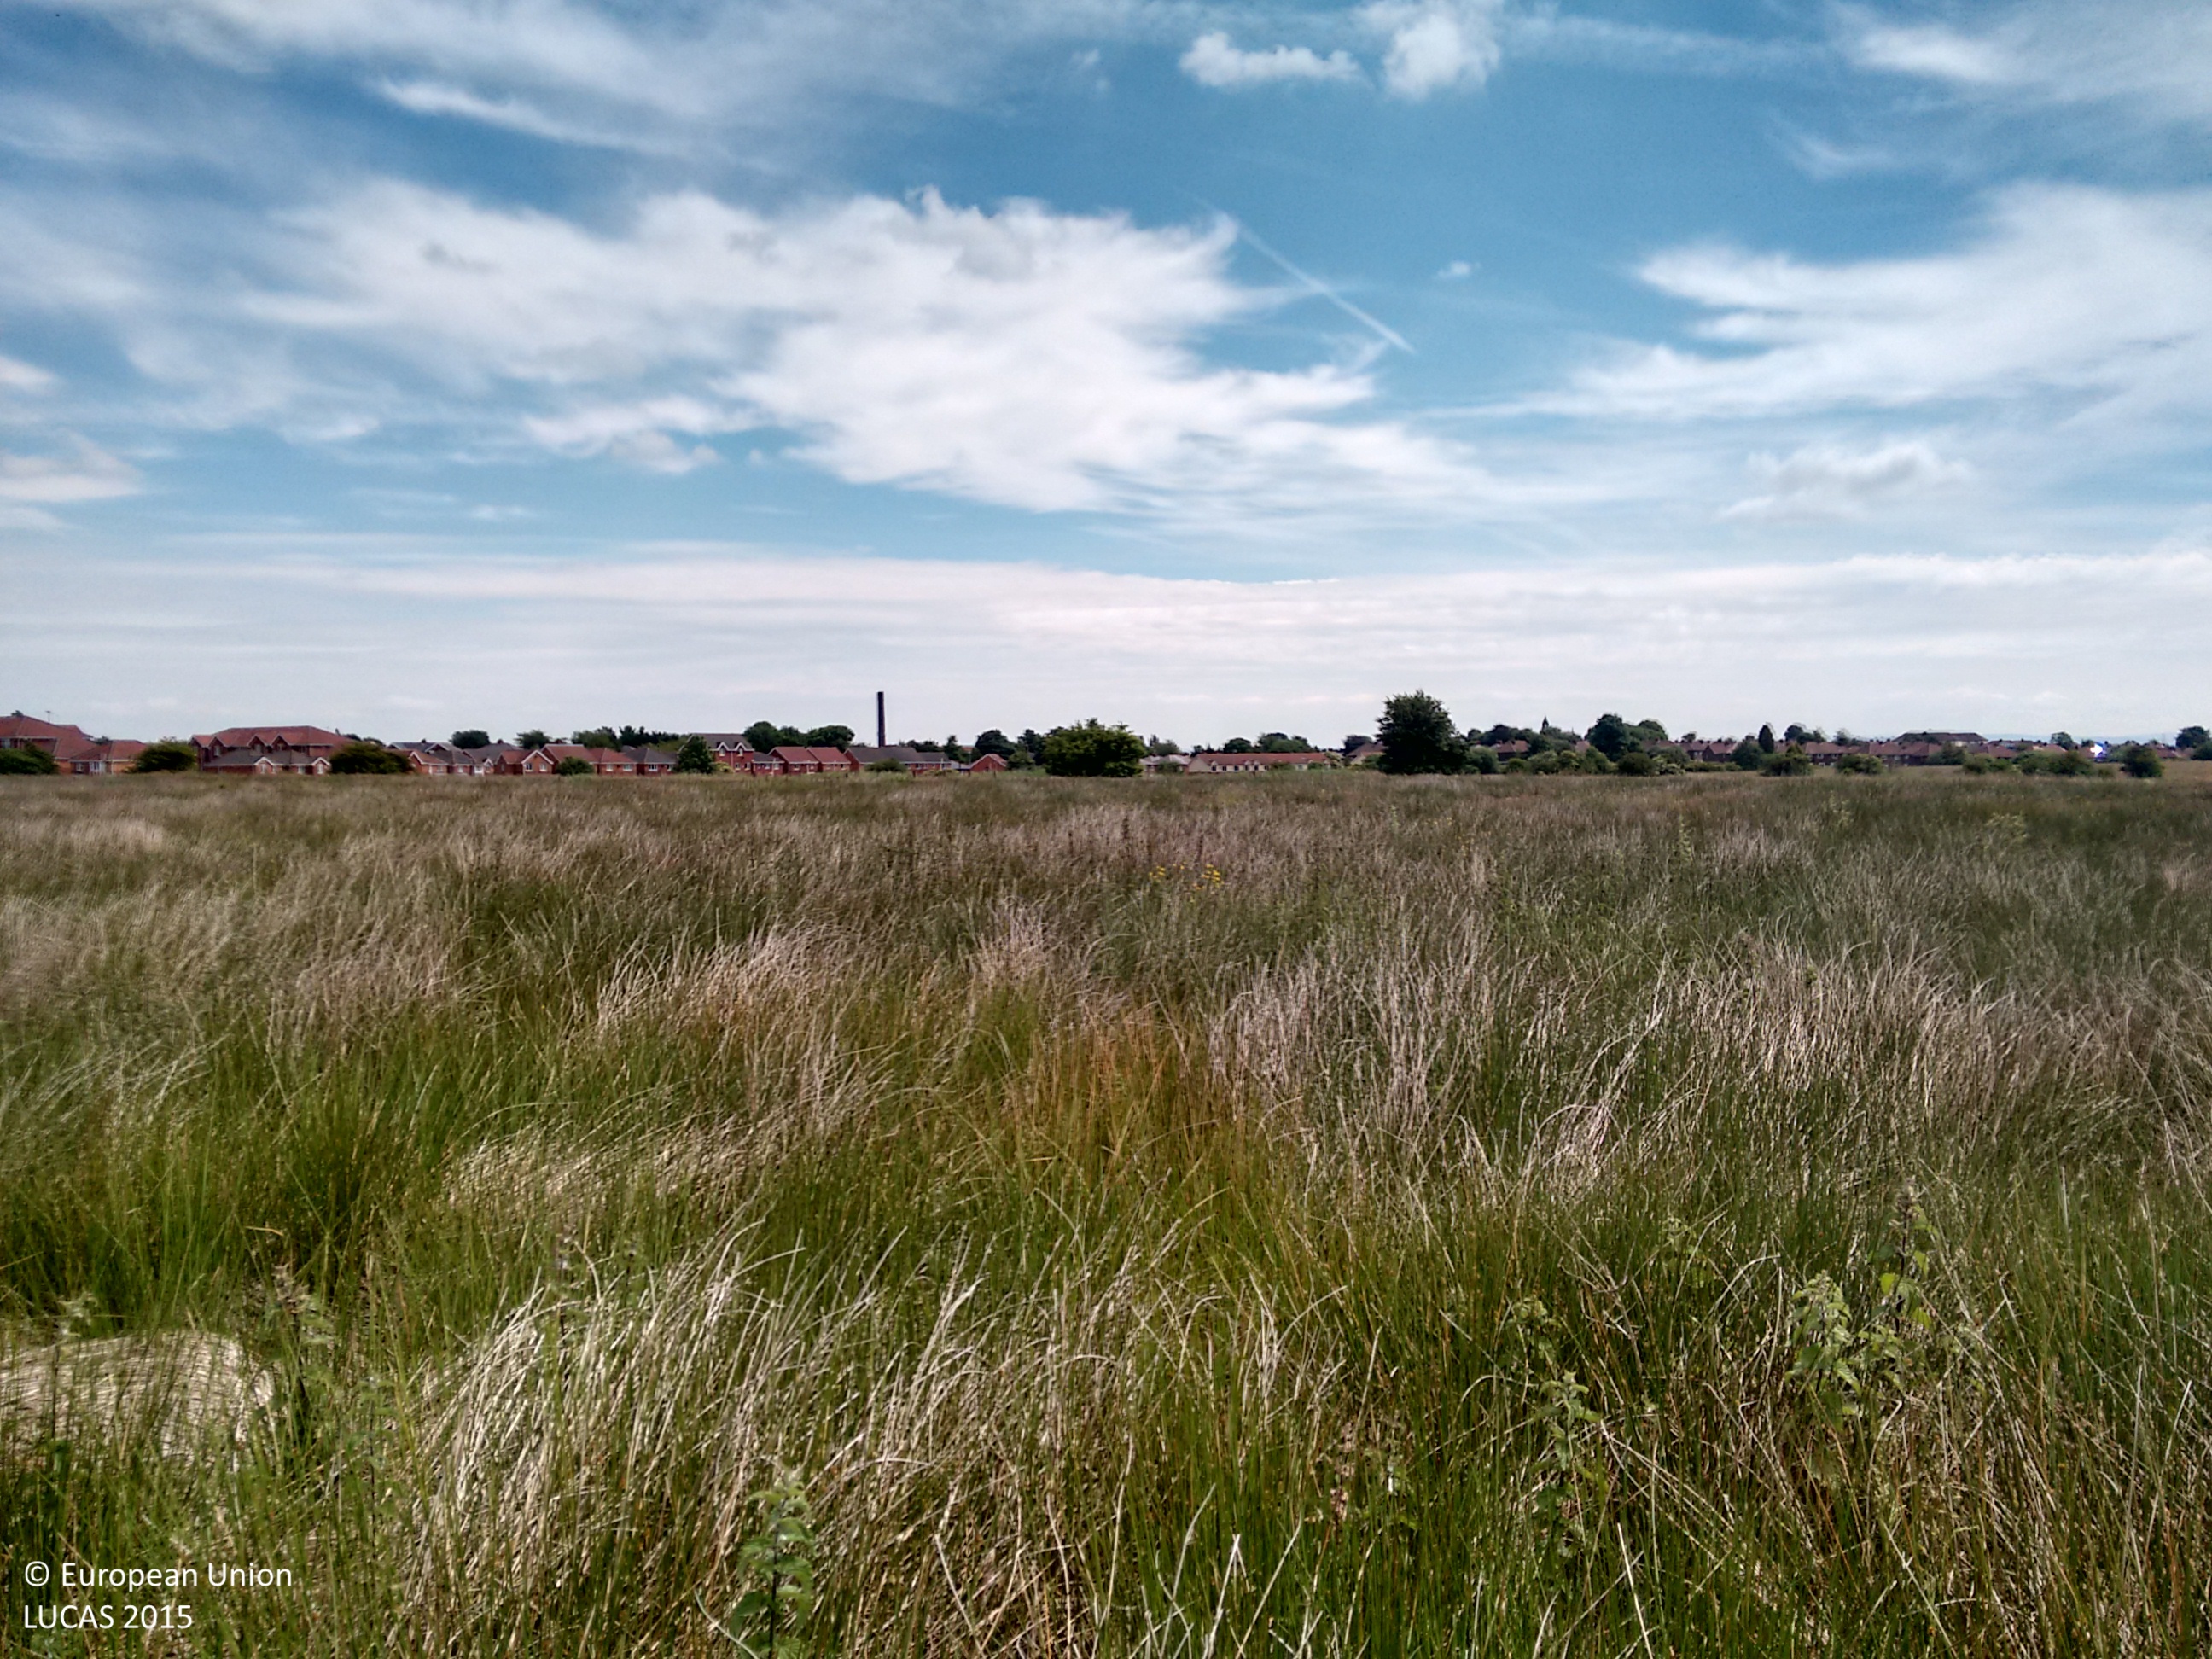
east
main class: Grassland
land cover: Grassland without tree/shrub cover
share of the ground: > 75 %
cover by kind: herbaceous plants 100 %
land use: Semi-natural and natural areas not in use
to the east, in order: Grassland without tree/shrub cover; Fences; Grassland without tree/shrub cover; Rivers and streams; Grassland without tree/shrub cover
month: June
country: GB
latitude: 53.5418
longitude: -2.4231
